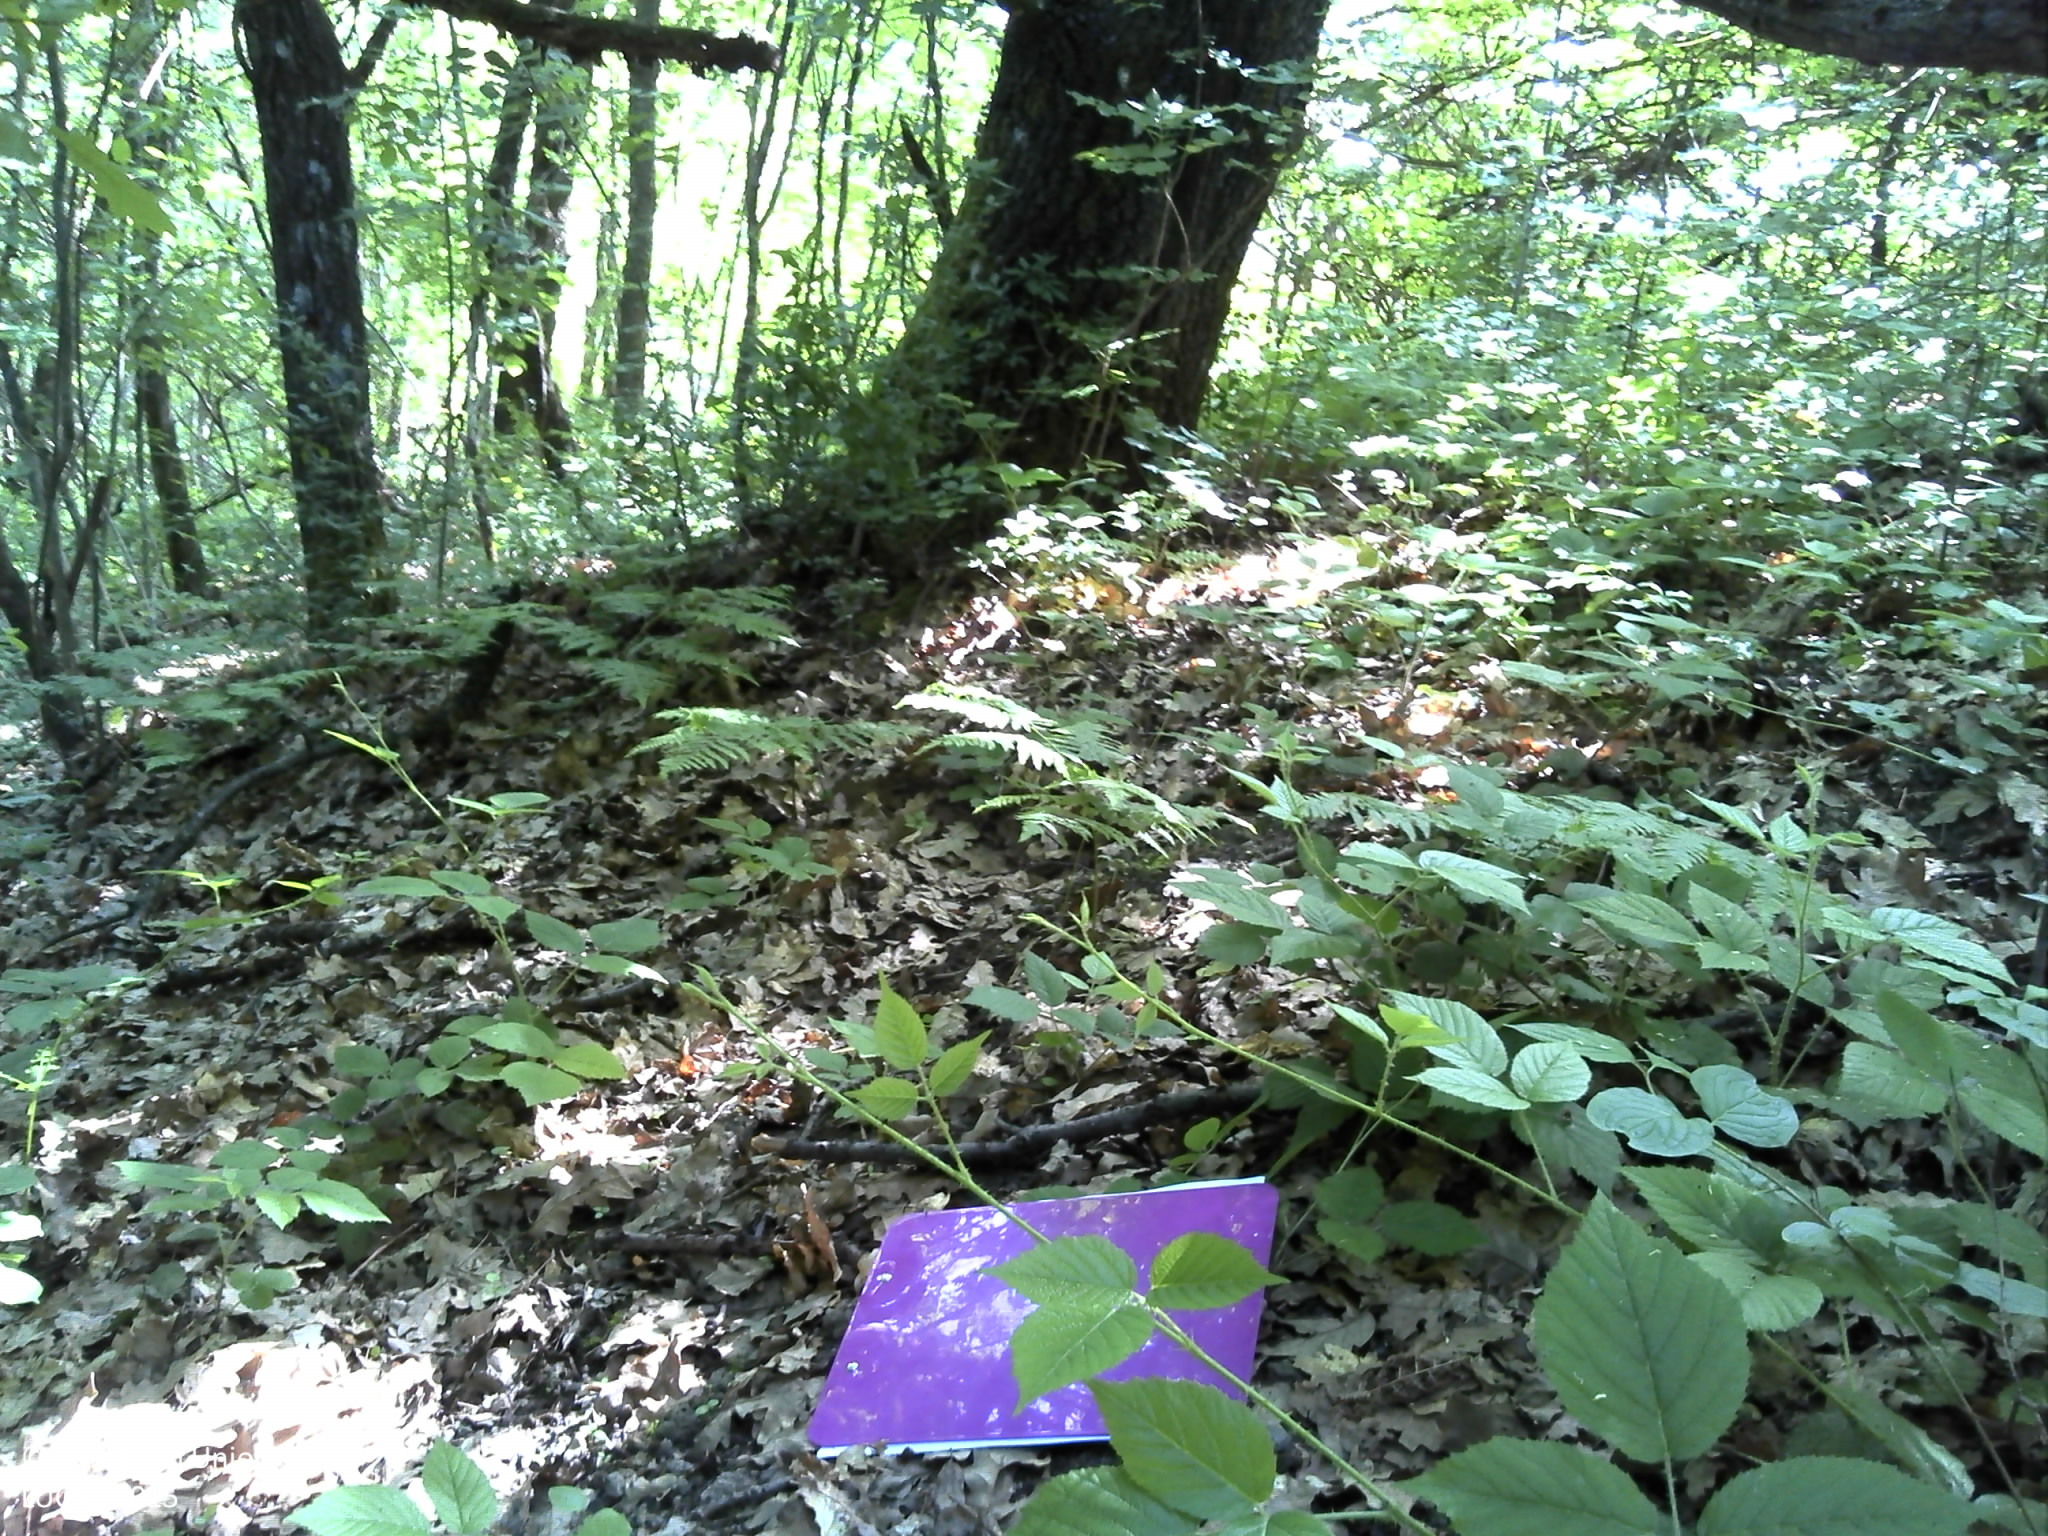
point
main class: Woodland
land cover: Broadleaved woodland
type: acidophilous oak and oak-birch forest
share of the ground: > 75 %
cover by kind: broadleaved forest trees 100 %
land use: Forestry
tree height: > 5 m
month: May
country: HR
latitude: 45.4344
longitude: 18.0184
